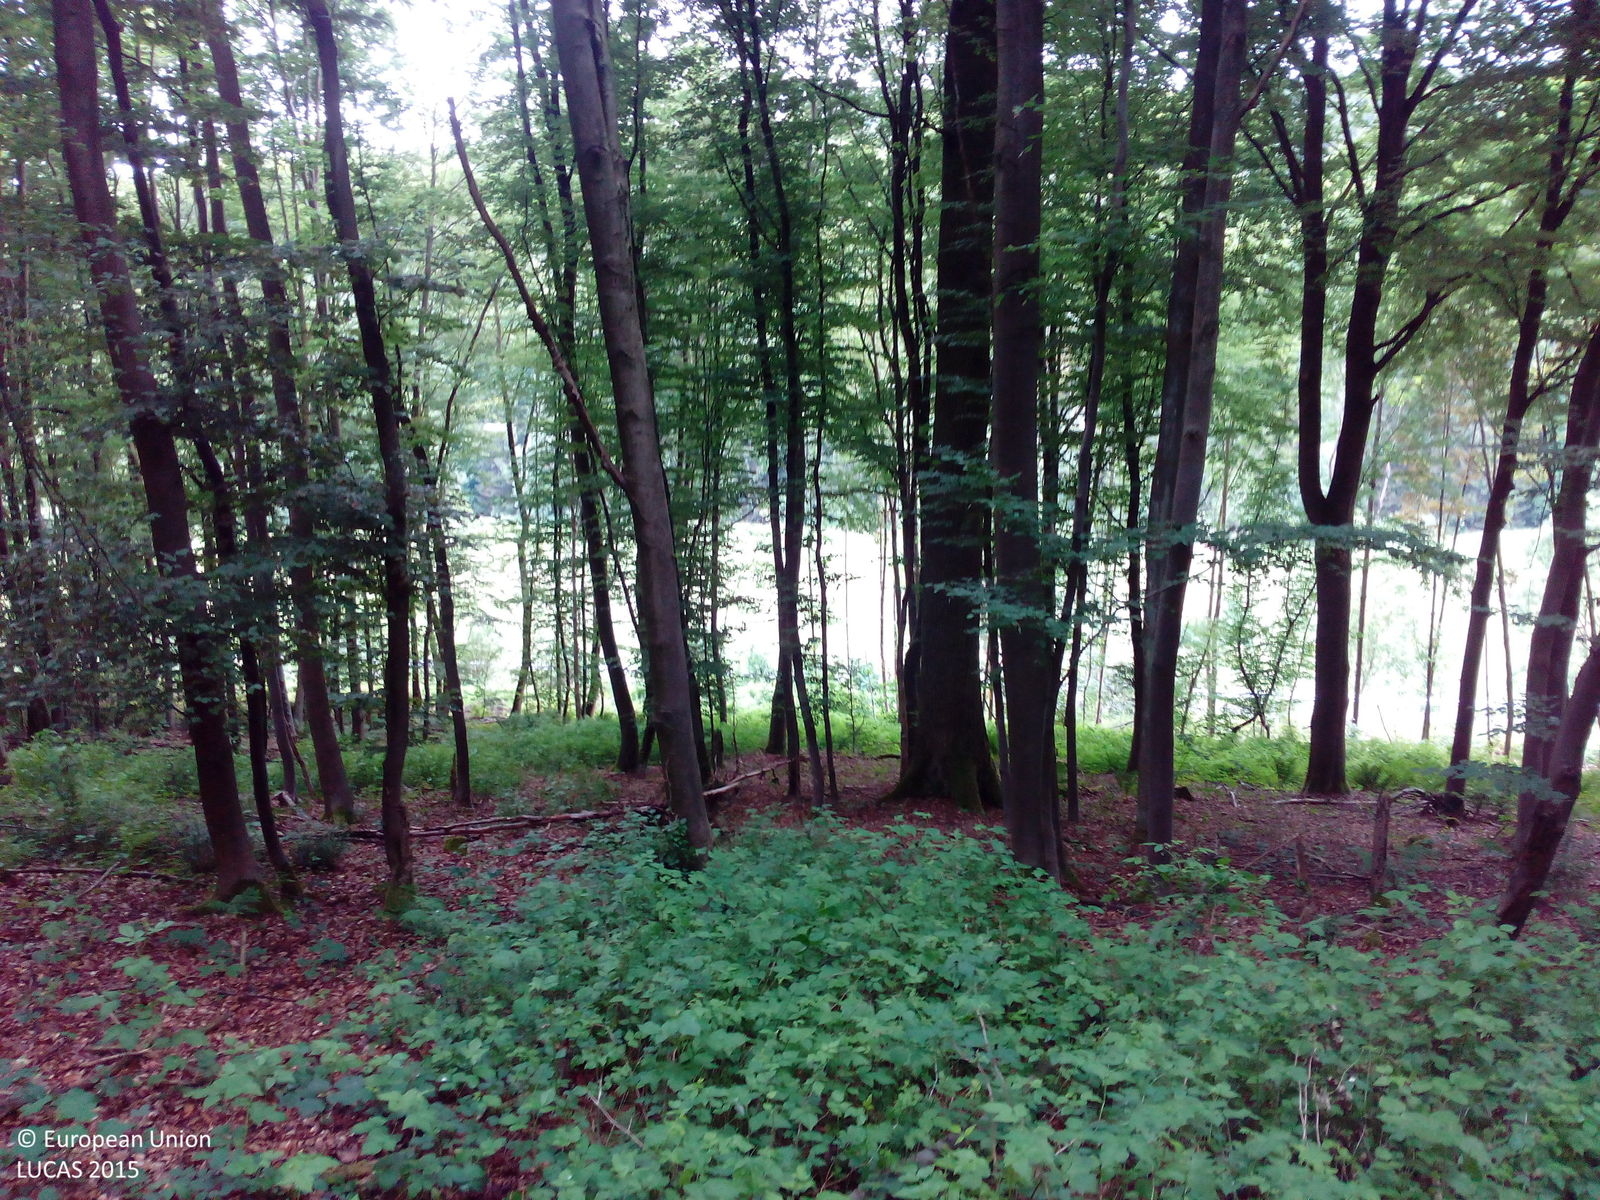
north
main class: Woodland
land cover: Broadleaved woodland
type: beech forest
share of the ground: > 75 %
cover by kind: broadleaved forest trees 85 %, herbaceous plants 10 %, coniferous forest trees 5 %
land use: Forestry
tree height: > 5 m
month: June
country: DE
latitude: 51.6220
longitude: 9.6390
